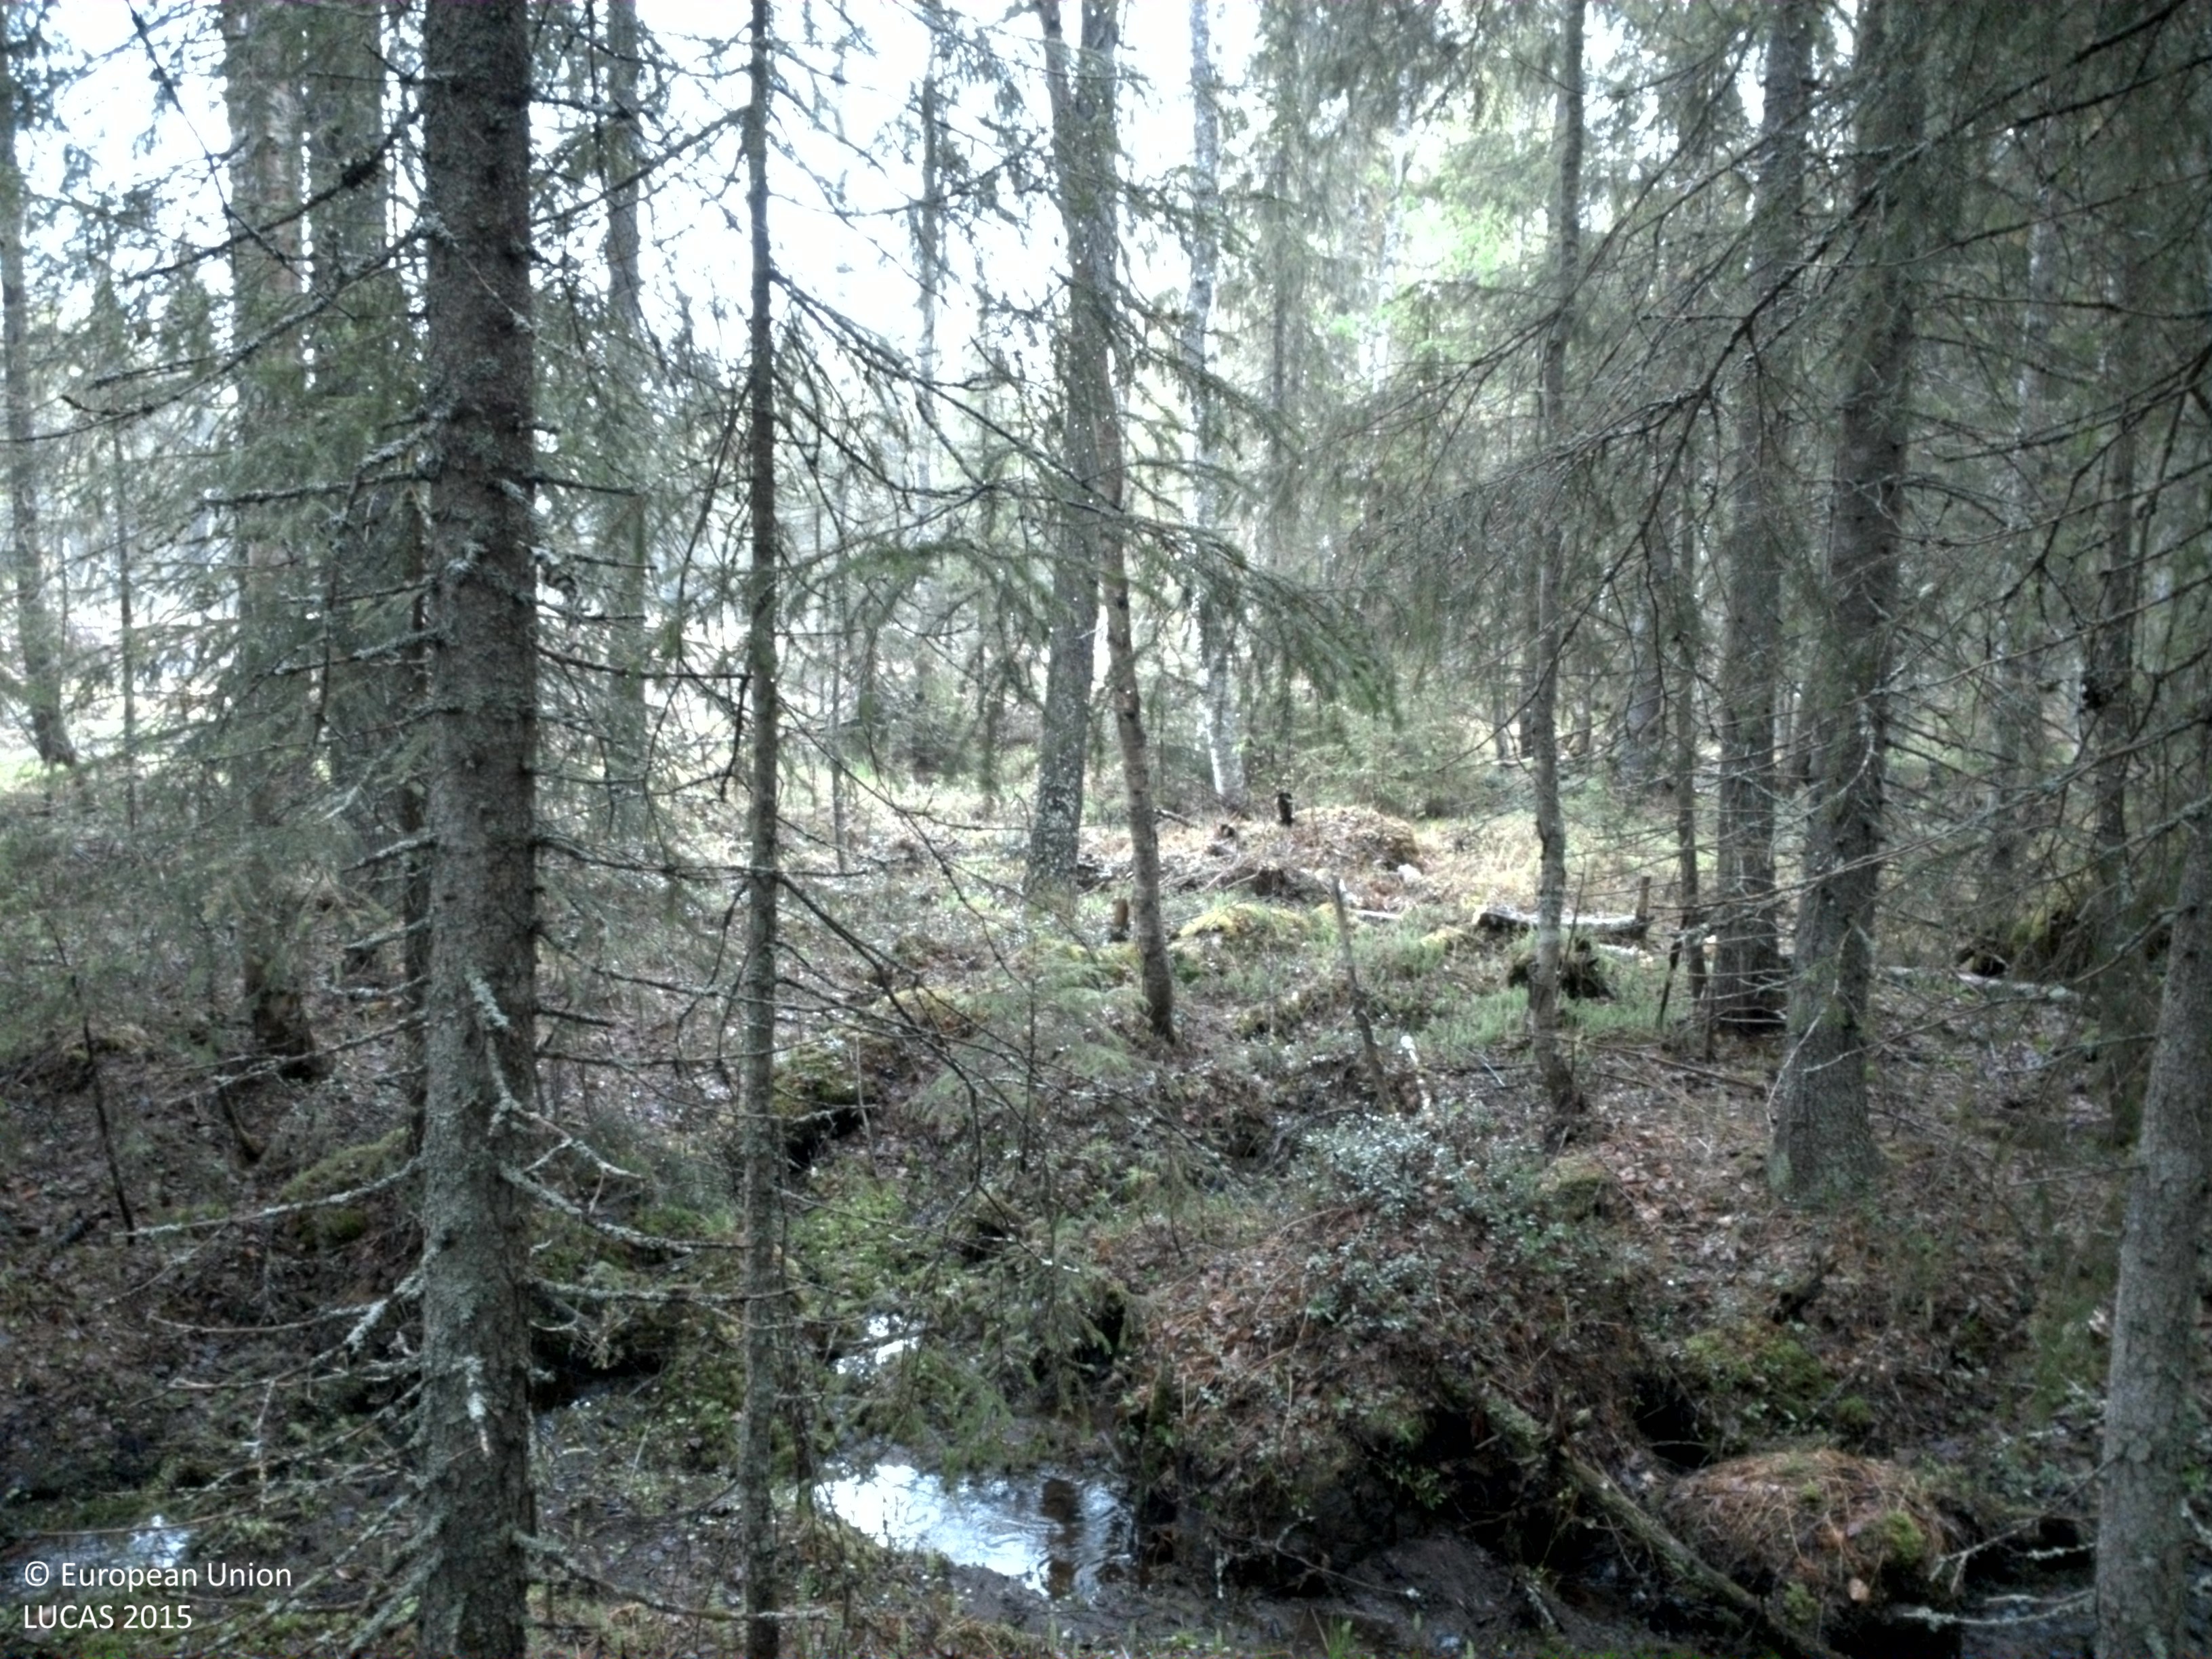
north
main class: Woodland
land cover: Spruce dominated coniferous woodland
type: boreal forest
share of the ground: 50 - 75 %
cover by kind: coniferous forest trees 65 %, shrubs 15 %, herbaceous plants 10 %, broadleaved forest trees 5 %, lichens and mosses 5 %
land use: Forestry
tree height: > 5 m
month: June
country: SE
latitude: 66.0273
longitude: 23.0197
